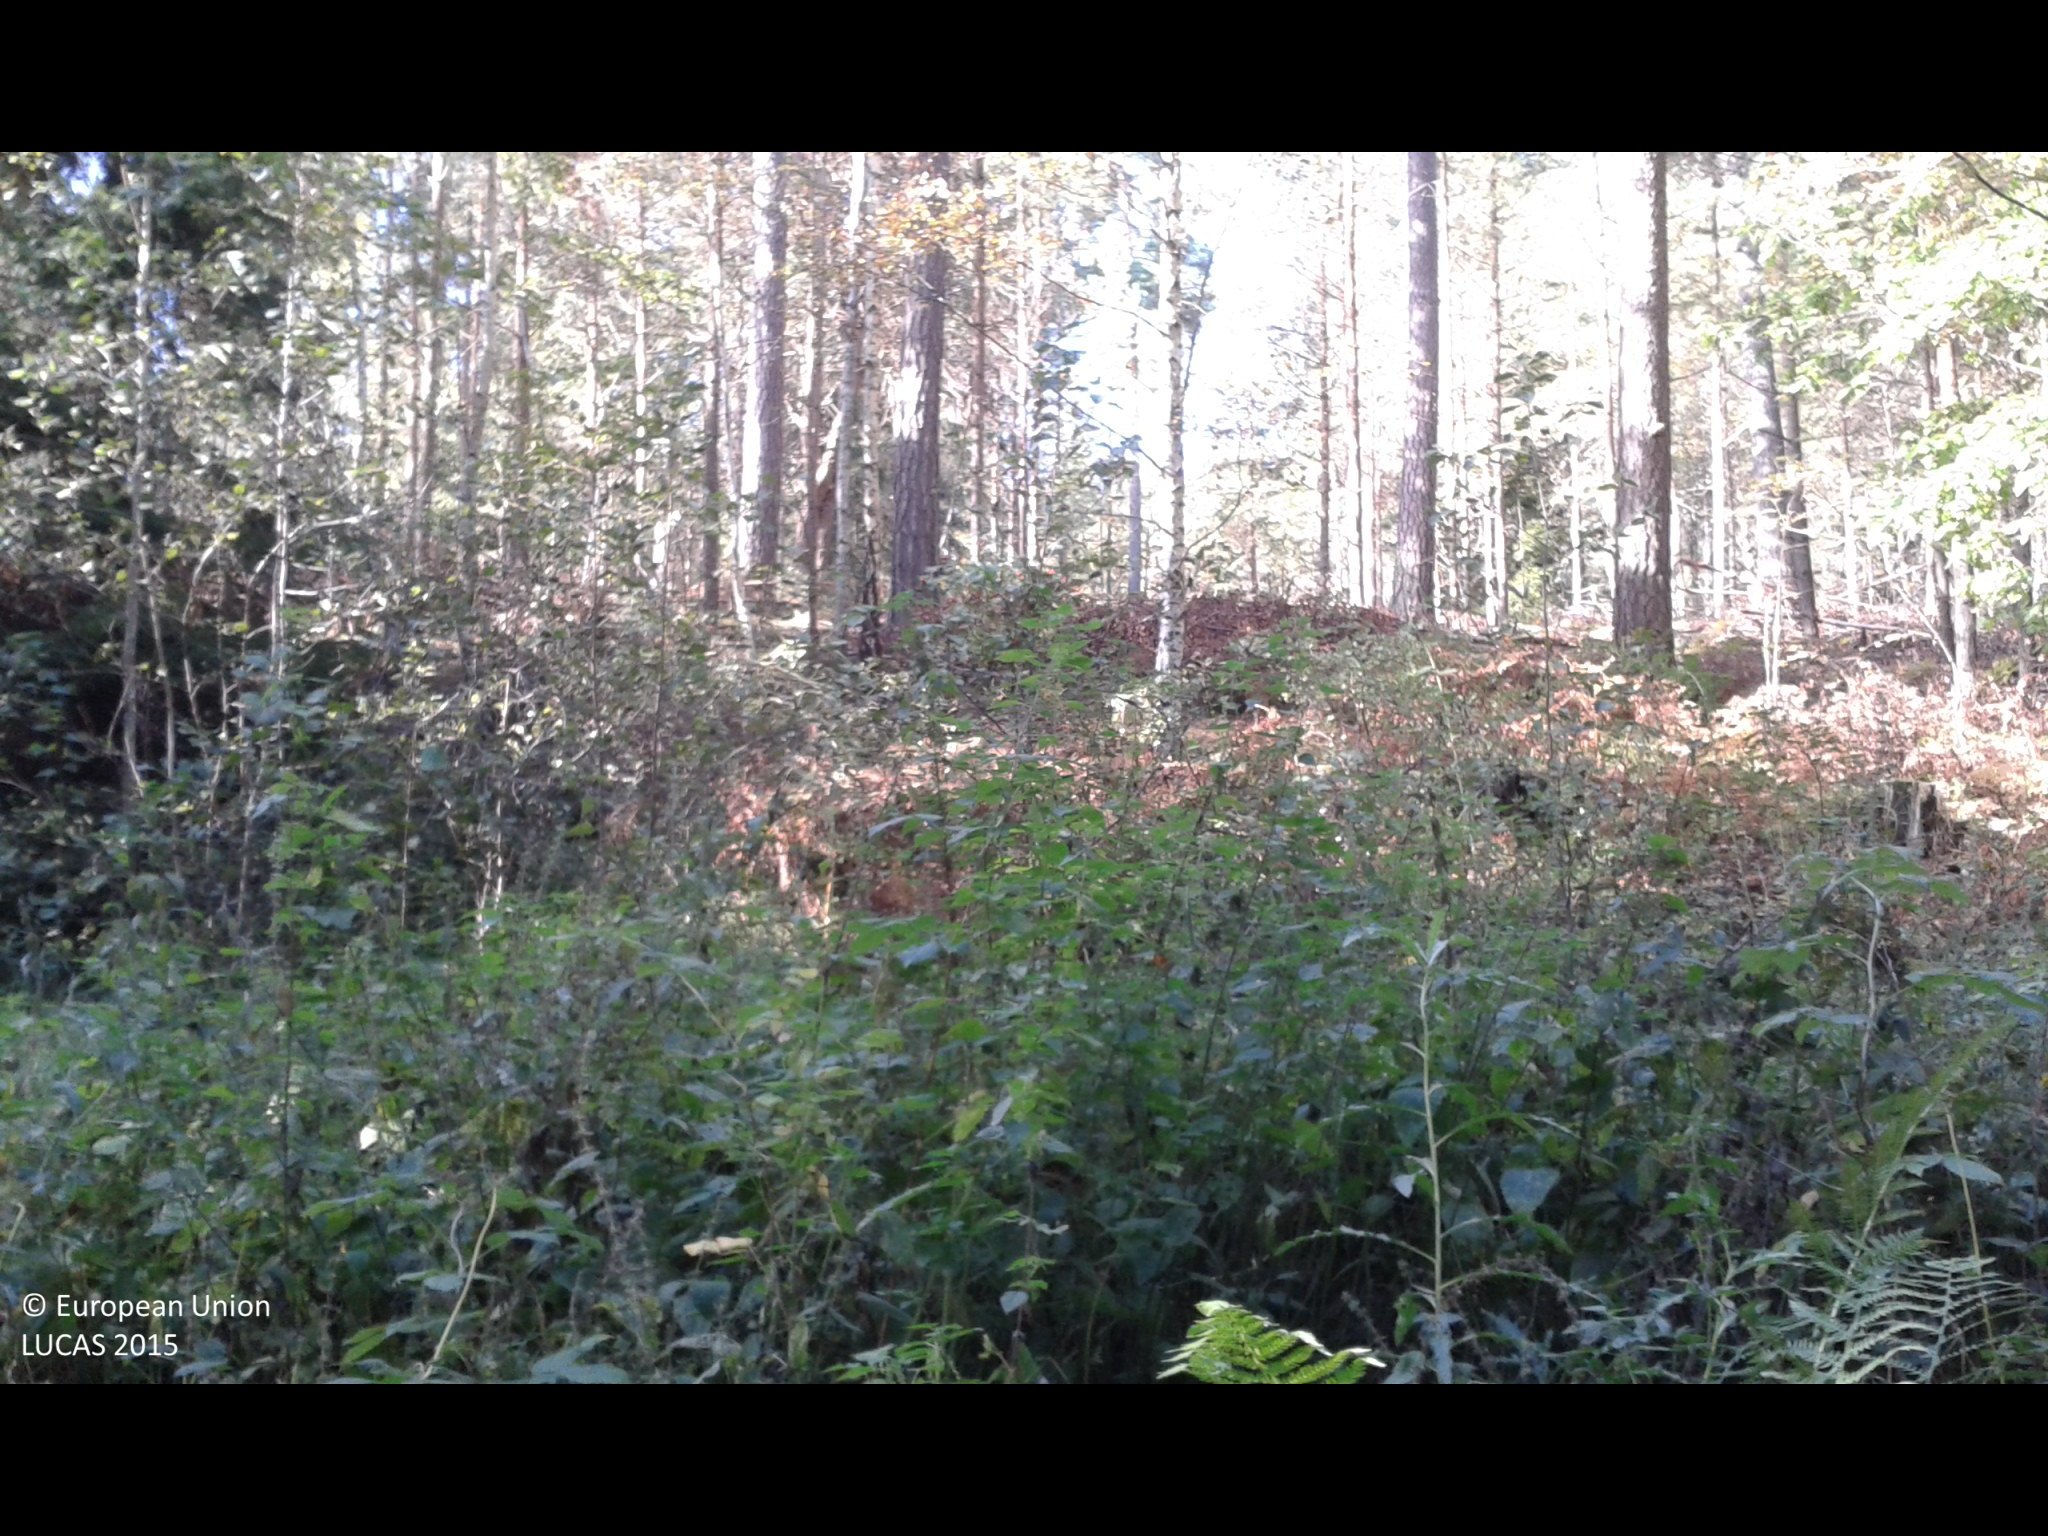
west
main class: Woodland
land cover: Broadleaved woodland
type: hemiboreal forest and nemoral coniferous forest and mixed broadleaved-coniferous forest
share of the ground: > 75 %
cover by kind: broadleaved forest trees 100 %
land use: Amenities, museums, leisure
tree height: > 5 m
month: September
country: SE
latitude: 58.9270
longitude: 17.5892
